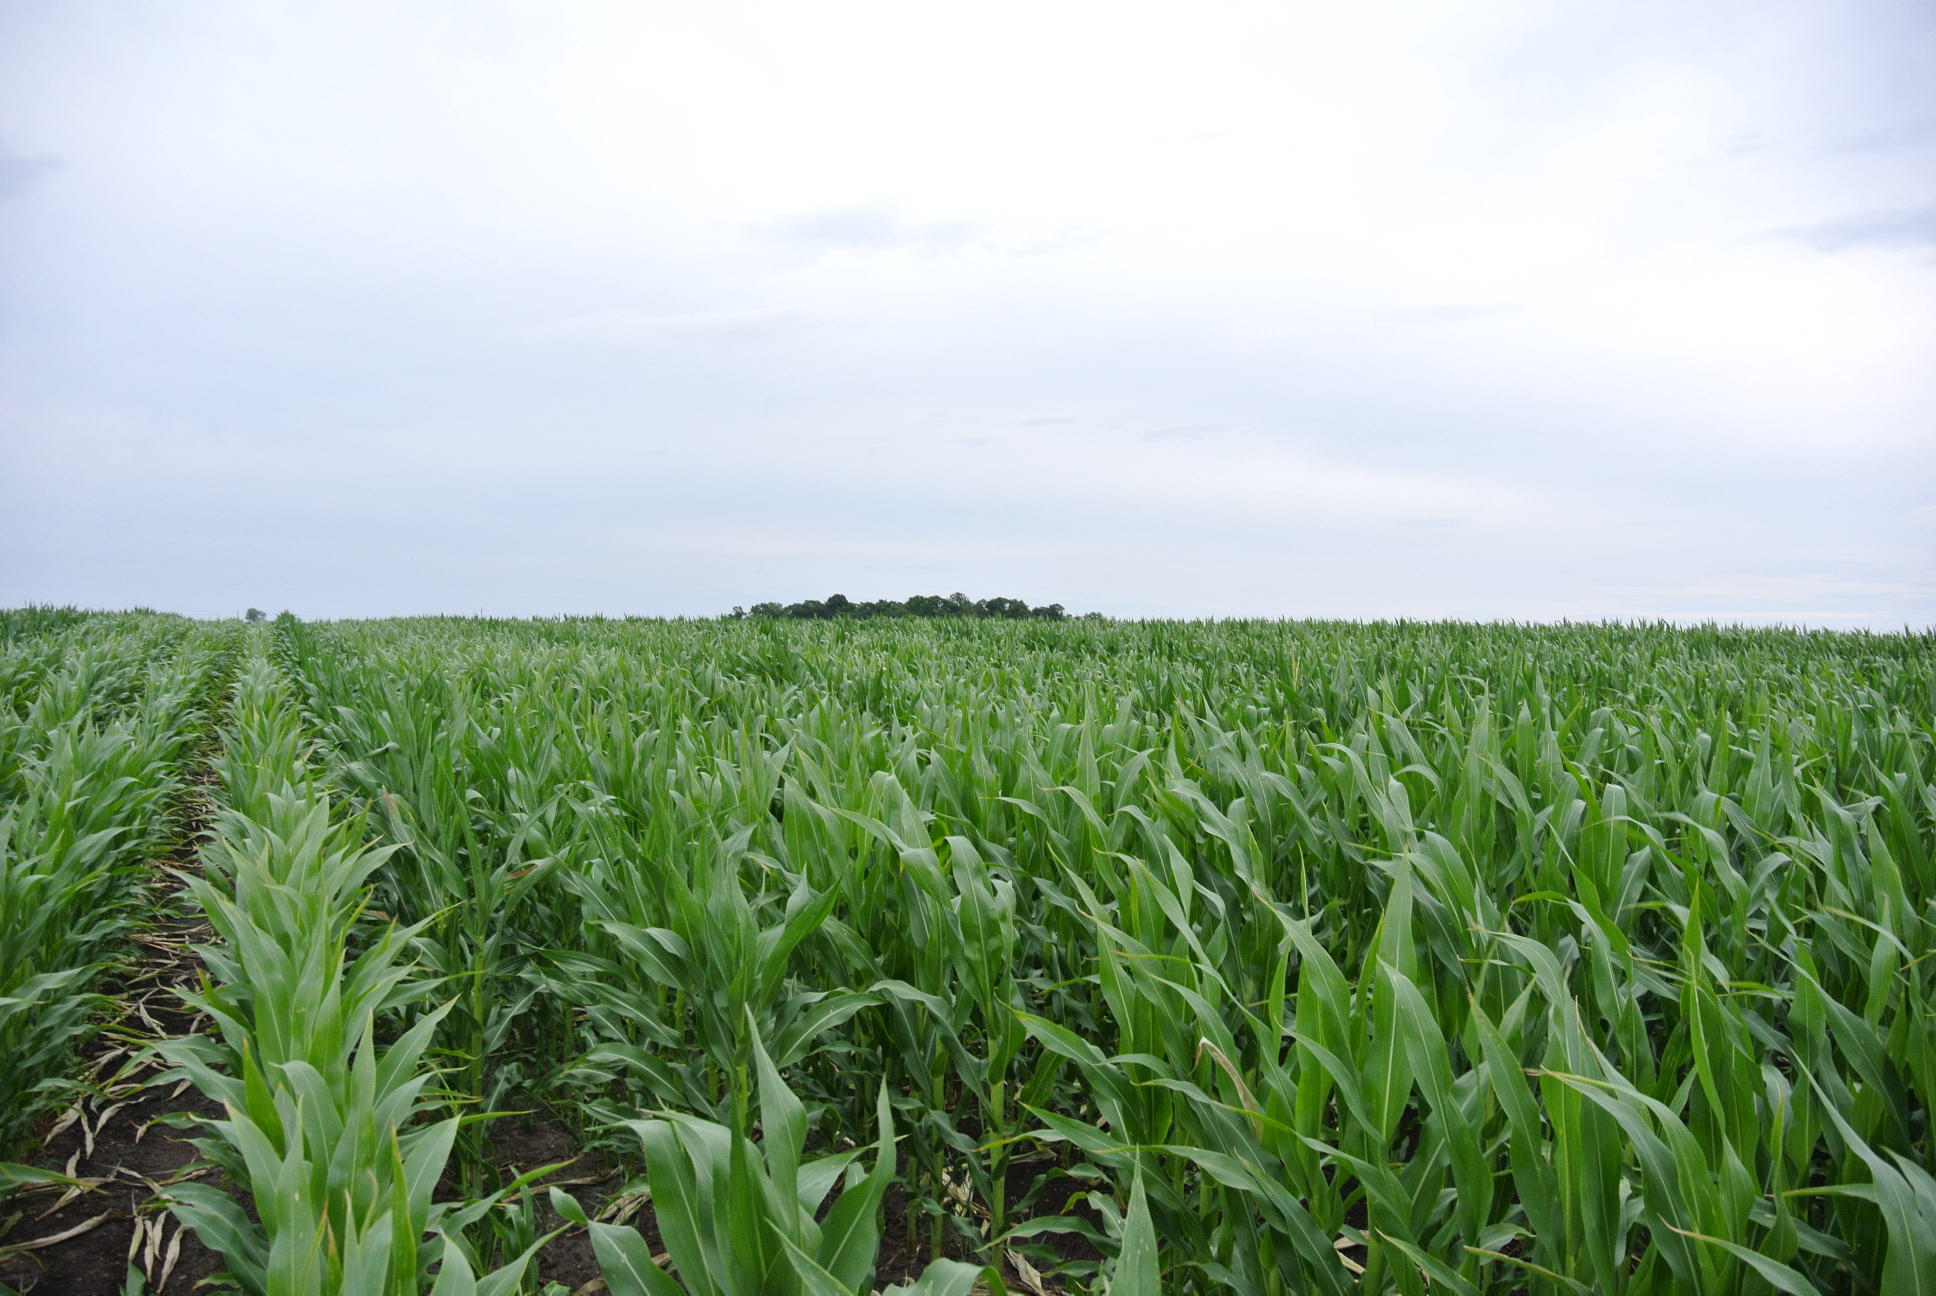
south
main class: Cropland
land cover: Maize
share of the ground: > 75 %
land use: Agriculture (excluding fallow land and kitchen gardens)
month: July
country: AT
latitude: 47.7918
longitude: 16.8808
